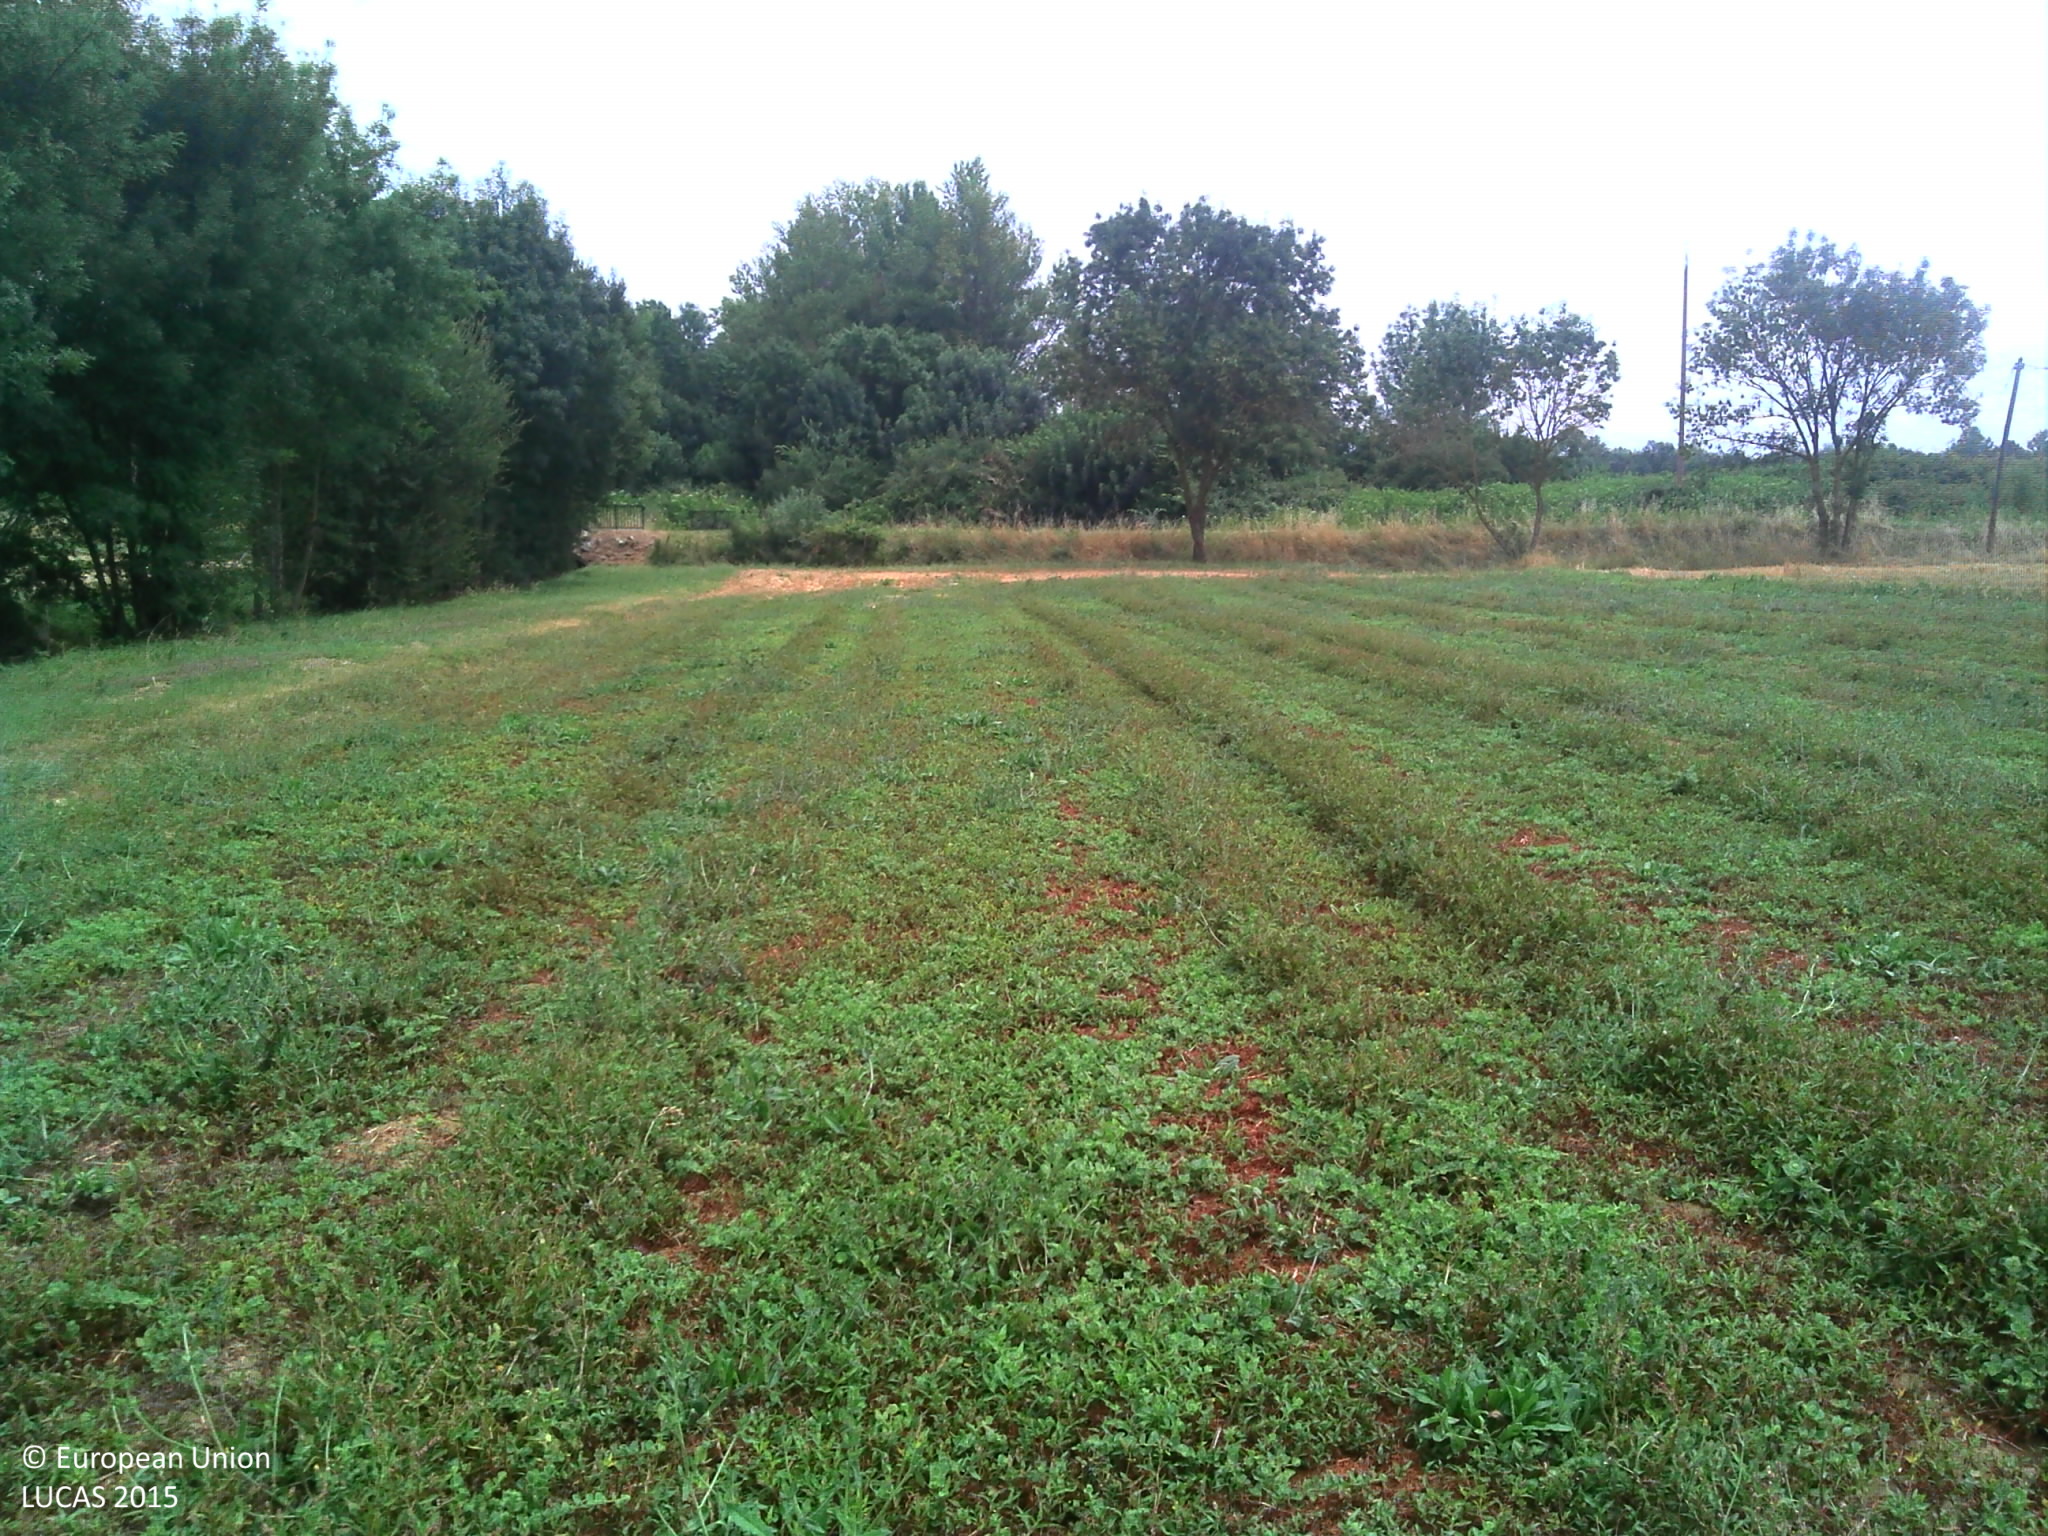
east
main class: Cropland
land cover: Temporary grasslands
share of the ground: > 75 %
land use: Agriculture (excluding fallow land and kitchen gardens)
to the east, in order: Temporary grasslands; Abandoned hedges; Rivers and streams; Ditches and canals; Paved roads, cycling and walking lanes; Grass margins; Electric lines; Grass margins; Broadleaved woodland; Other bare soil
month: July
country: FR
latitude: 43.8640
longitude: 0.9529
